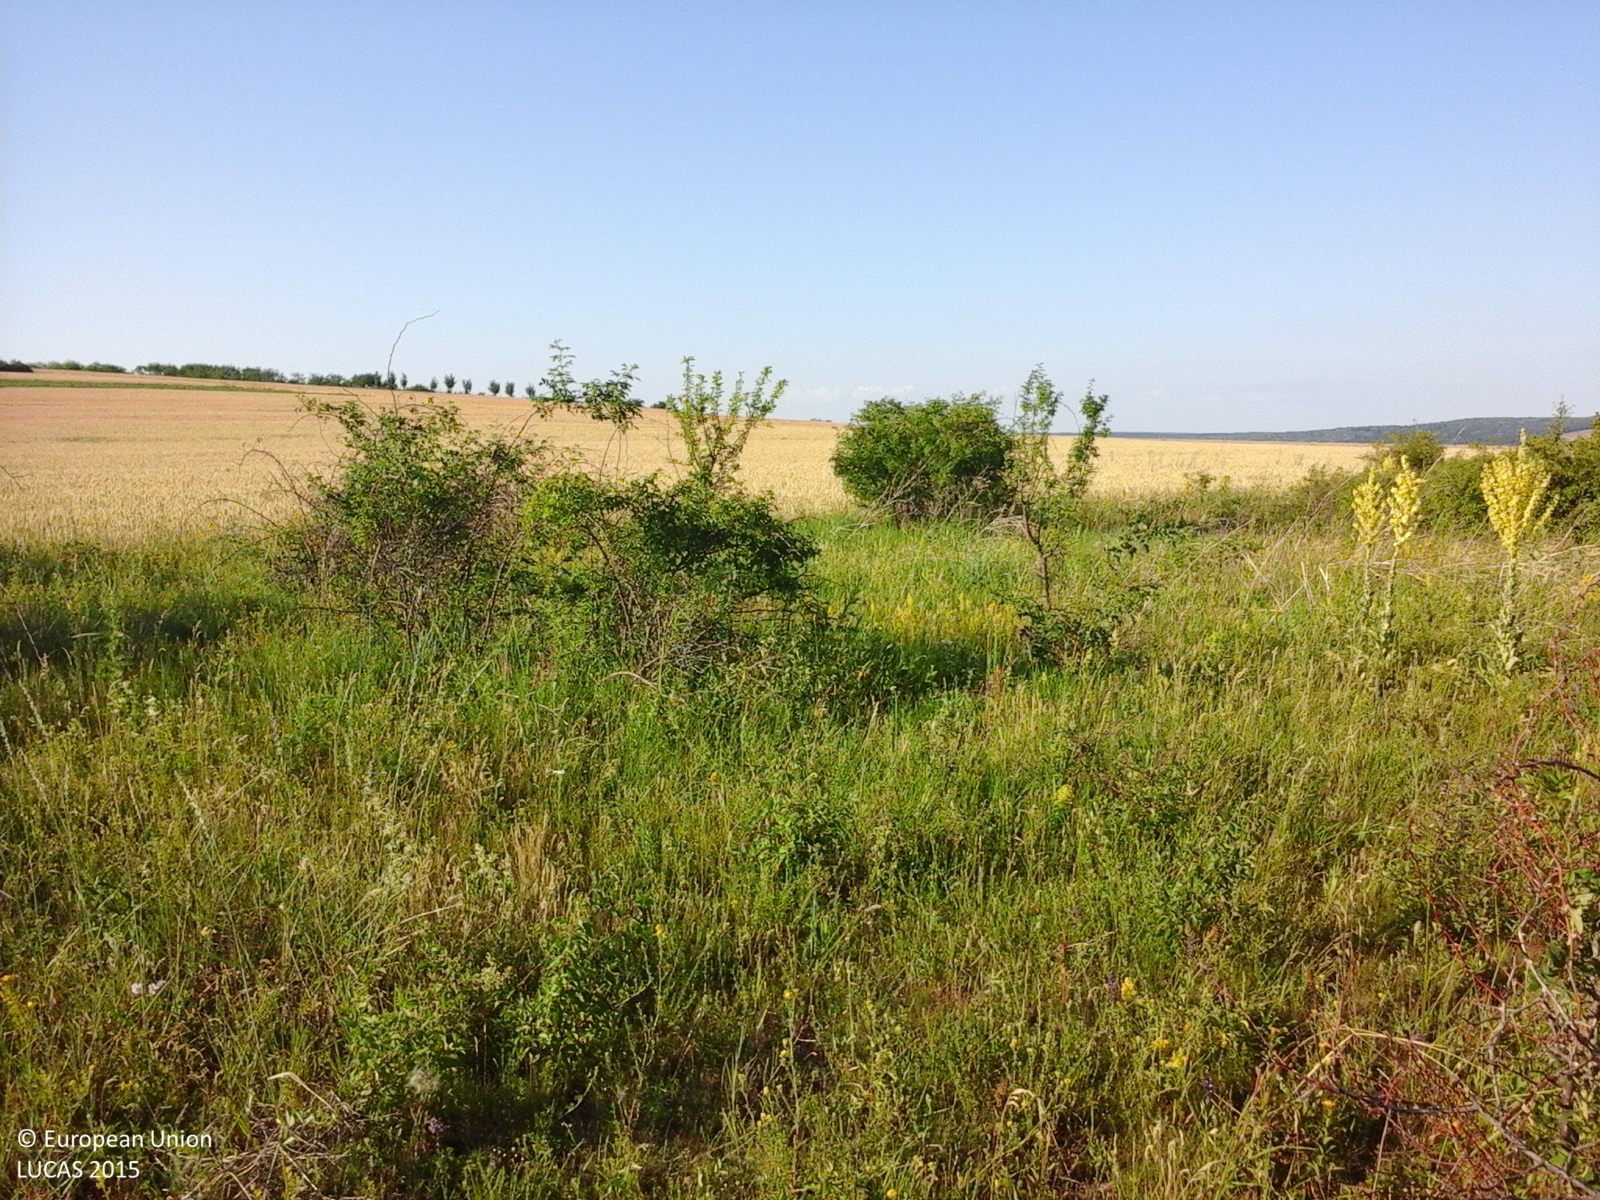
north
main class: Shrubland
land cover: Shrubland with sparse tree cover
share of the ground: > 75 %
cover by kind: herbaceous plants 50 %, shrubs 45 %, broadleaved forest trees 5 %
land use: Agriculture (excluding fallow land and kitchen gardens)
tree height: < 5 m
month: June
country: RO
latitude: 46.9305
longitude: 27.5444
